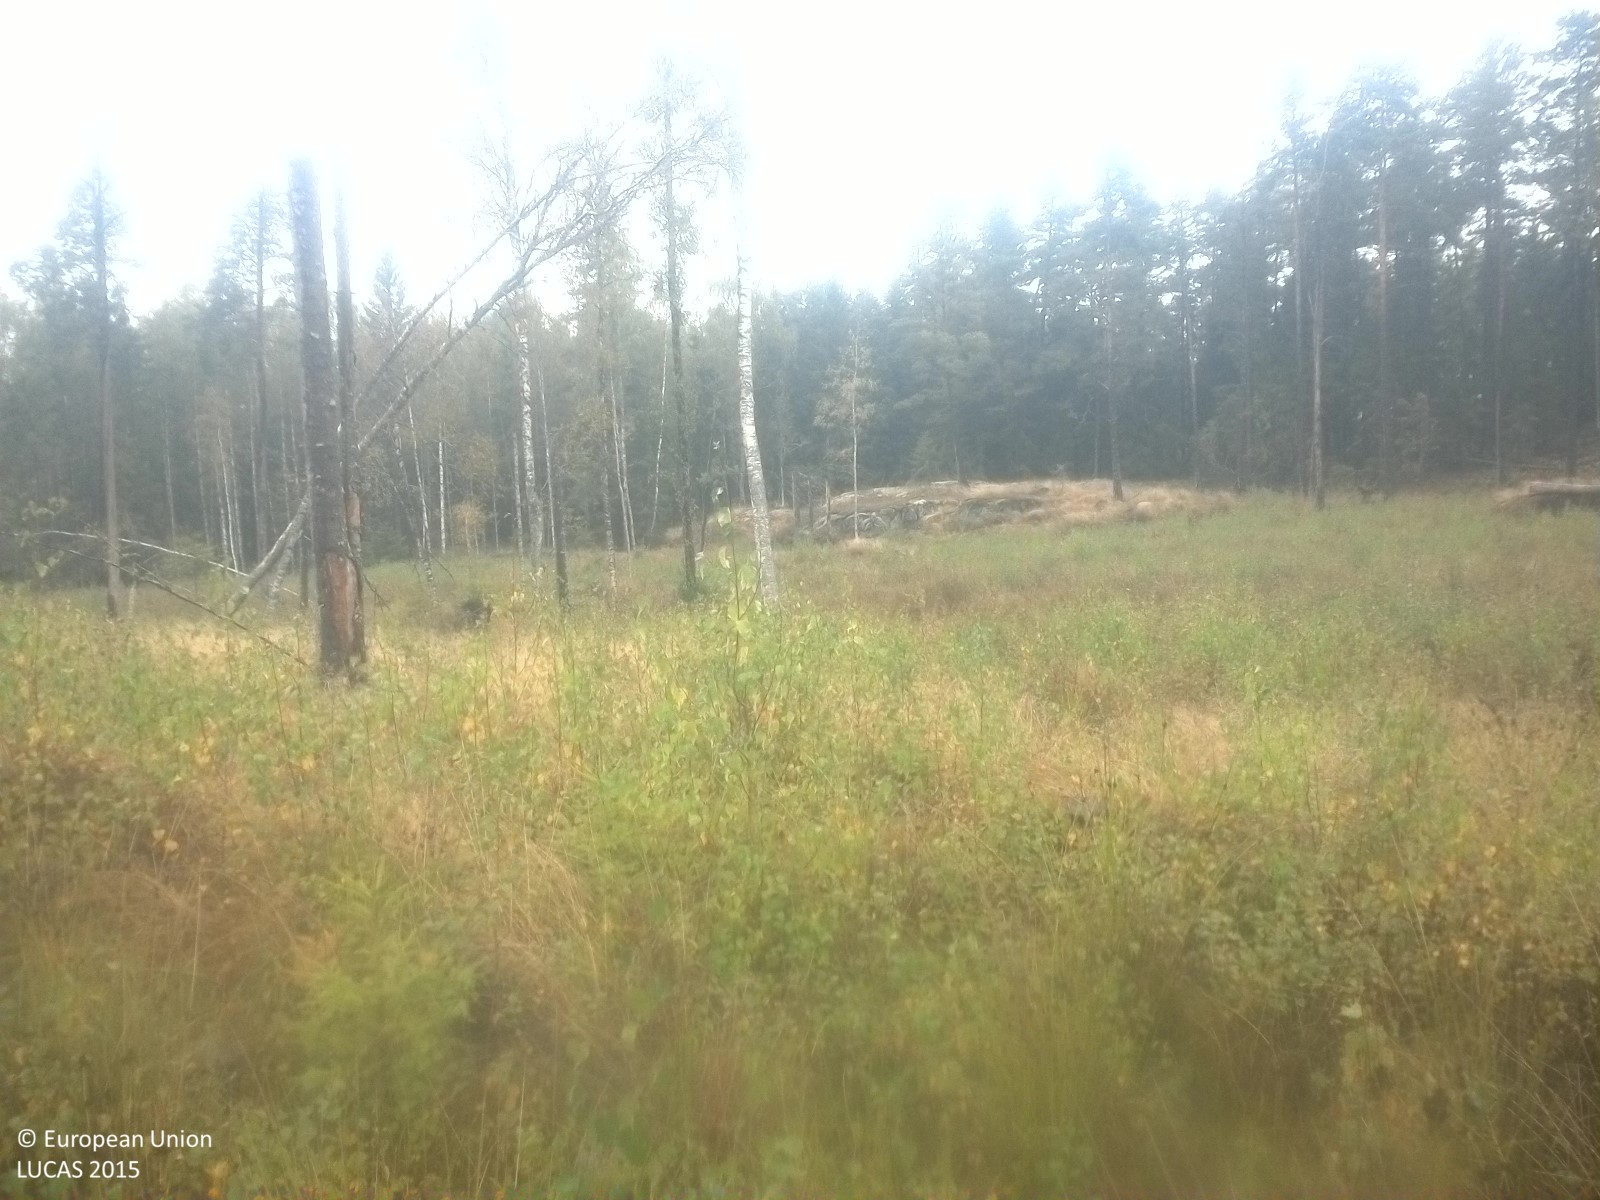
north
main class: Woodland
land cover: Broadleaved woodland
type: boreal forest
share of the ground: 50 - 75 %
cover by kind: broadleaved forest trees 55 %, herbaceous plants 35 %, coniferous forest trees 5 %, lichens and mosses 5 %
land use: Forestry
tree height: < 5 m
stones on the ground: 10 - 25 %
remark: Clear cut
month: September
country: SE
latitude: 58.5197
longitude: 16.7441
